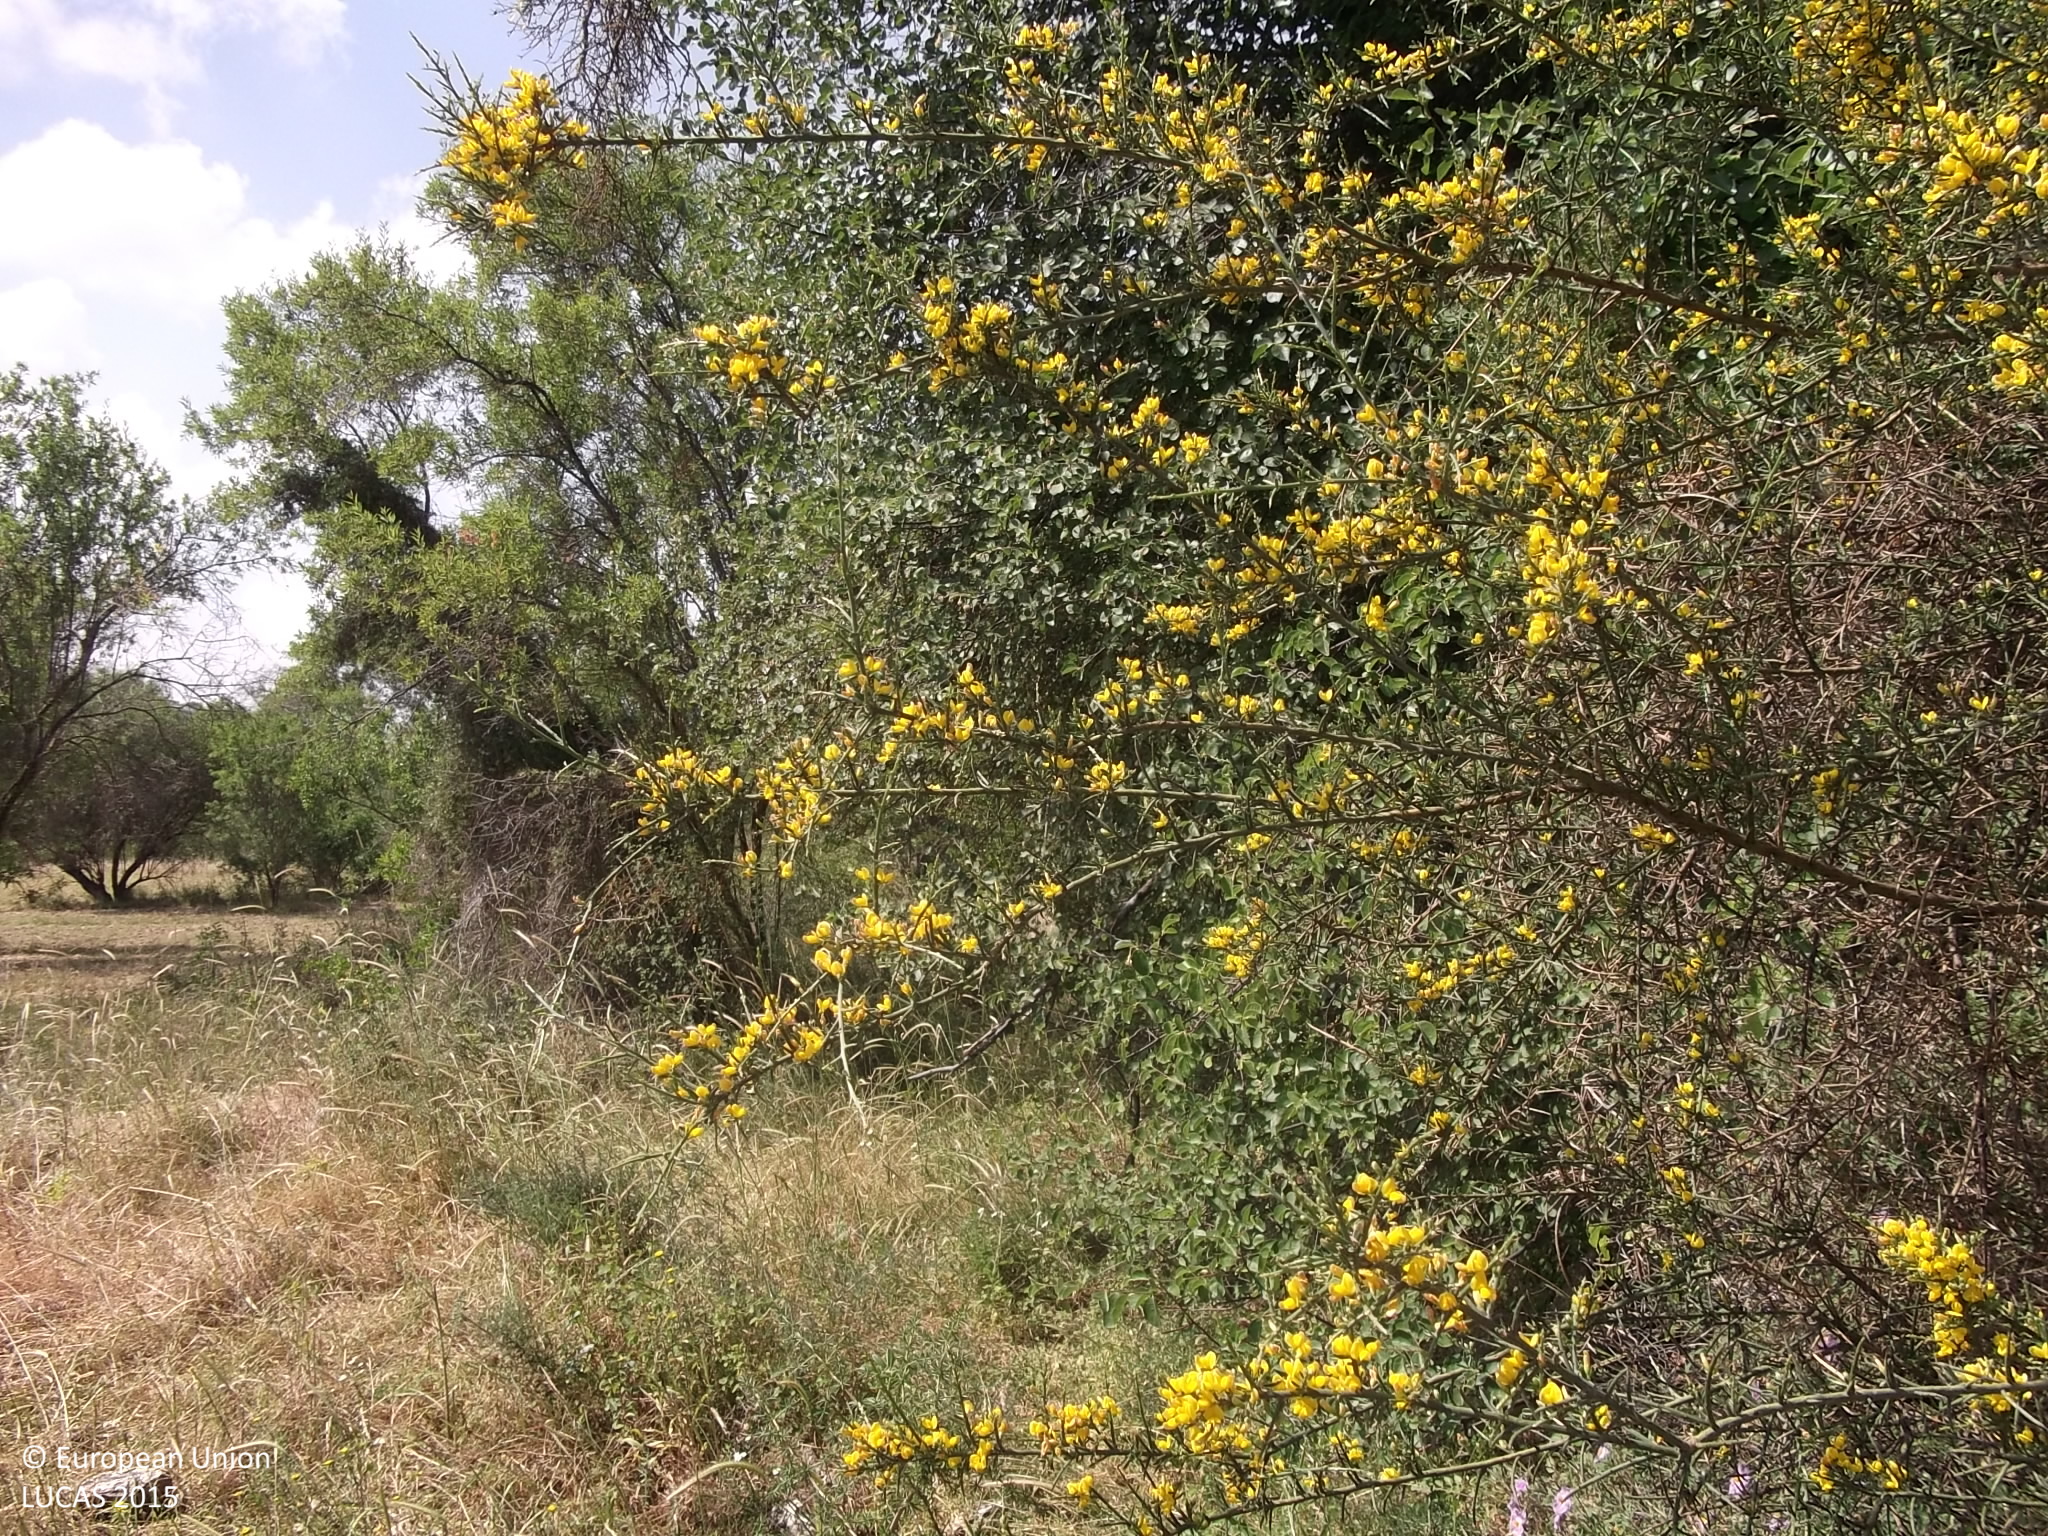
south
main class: Shrubland
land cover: Shrubland with sparse tree cover
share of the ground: 25 - 50 %
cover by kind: shrubs 50 %, herbaceous plants 35 %, unconsolidated bare surface 10 %, broadleaved forest trees 5 %
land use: Semi-natural and natural areas not in use
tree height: < 5 m
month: May
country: CY
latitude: 34.8714
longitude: 32.5459
